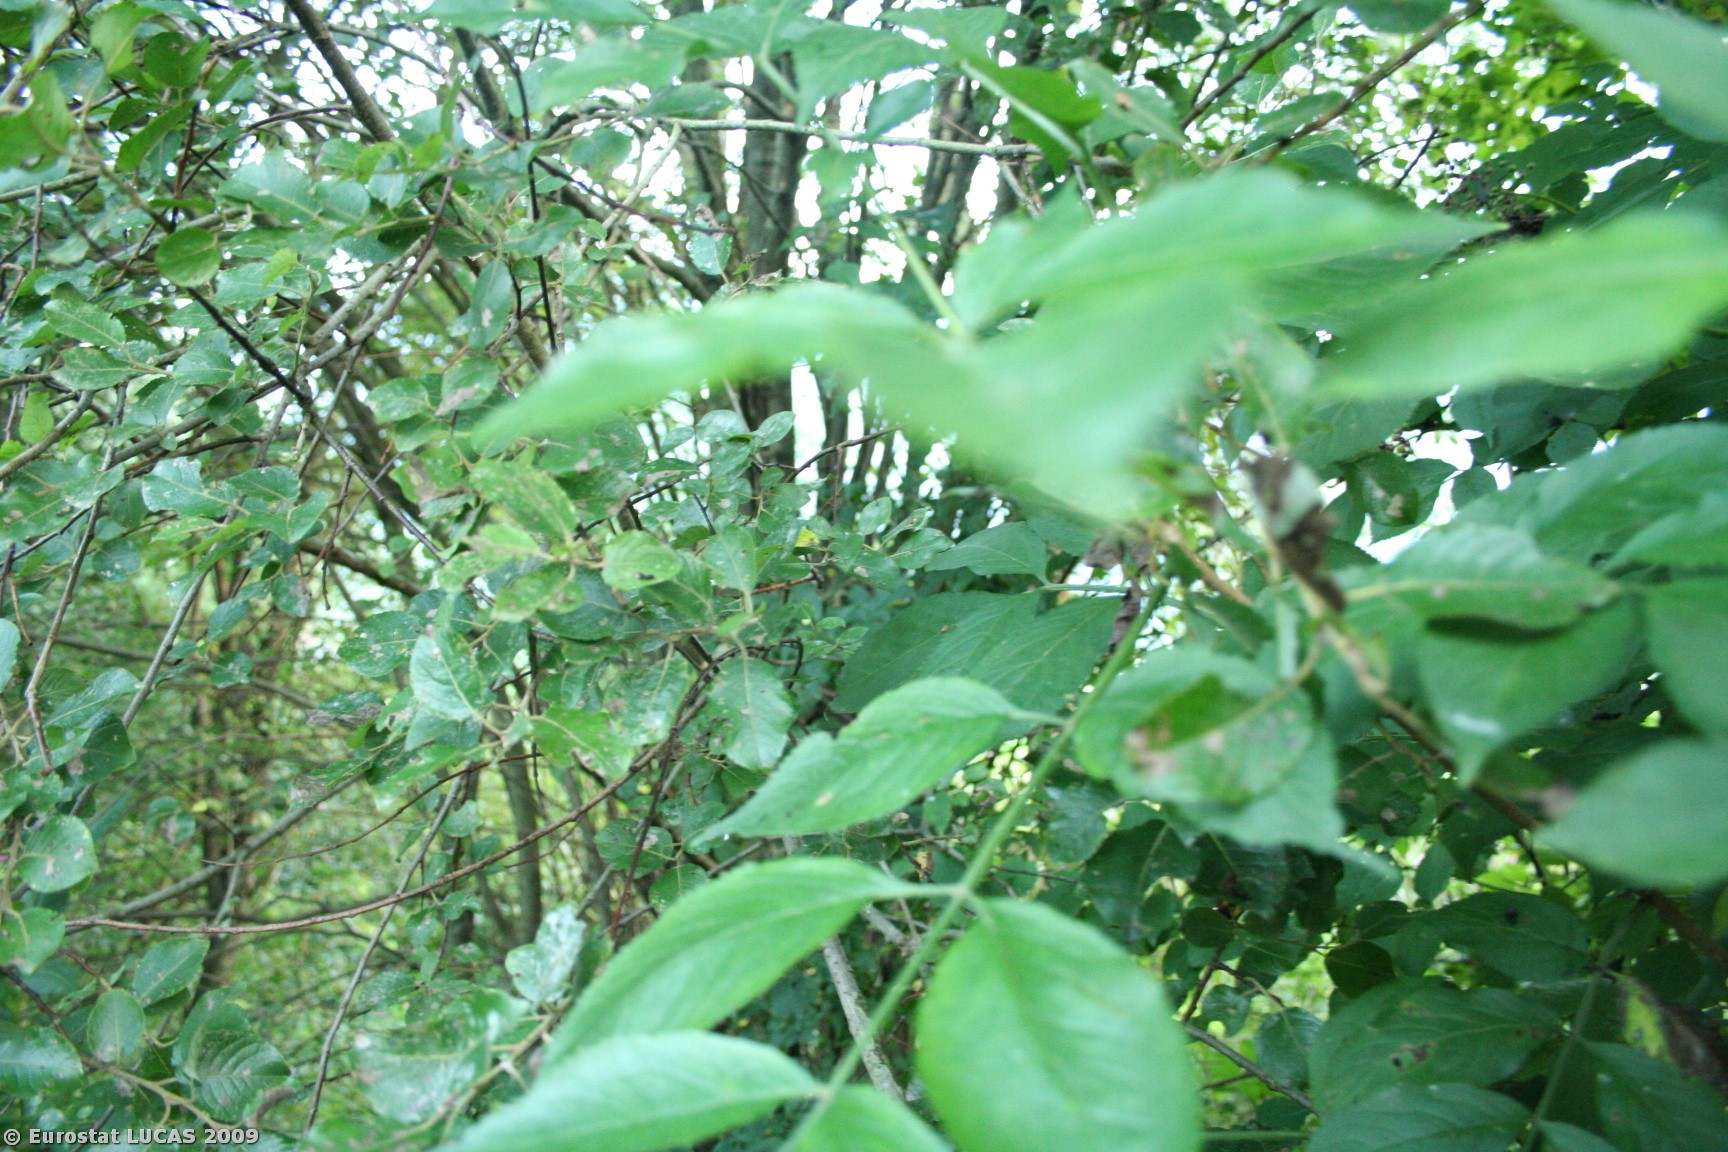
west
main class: Shrubland
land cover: Shrubland without tree cover
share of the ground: > 75 %
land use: Unused
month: August
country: AT
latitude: 47.4507
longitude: 11.9216
